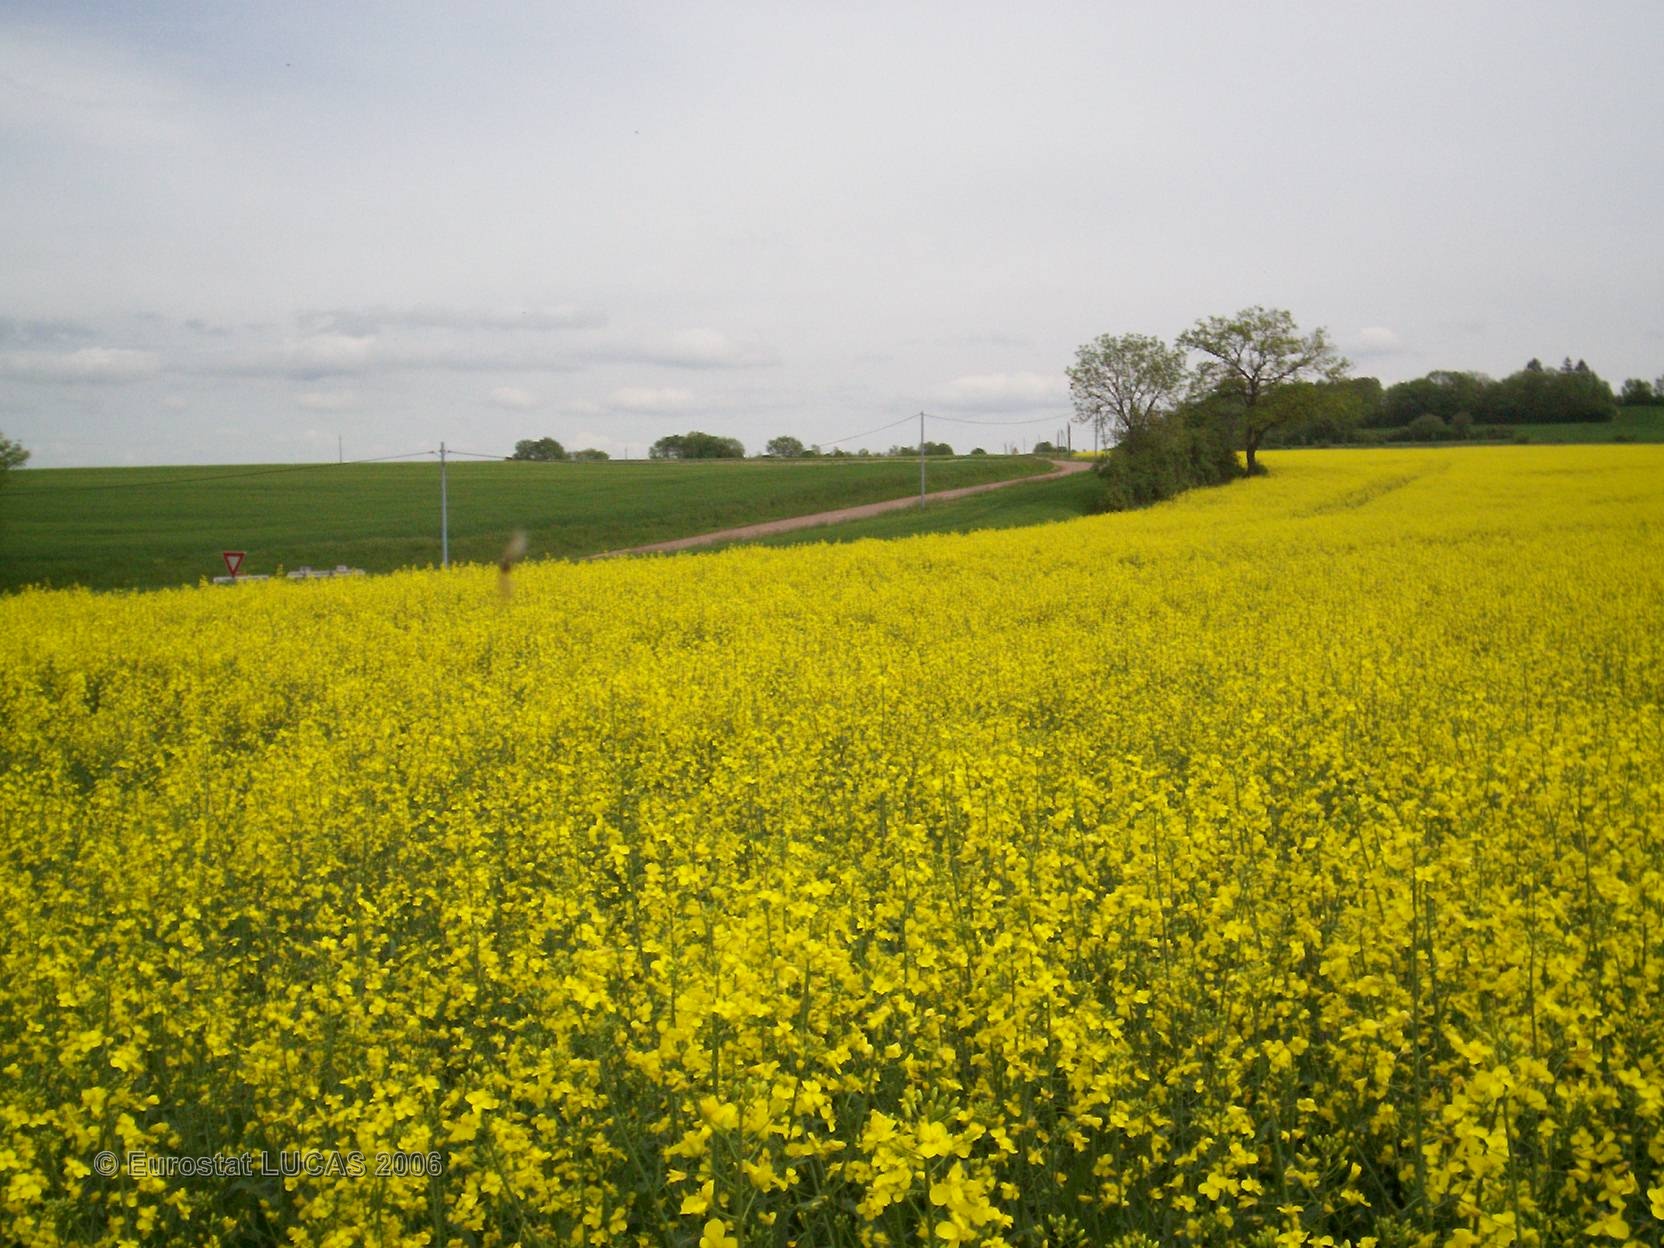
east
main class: Cropland
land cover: Rape and turnip rape
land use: Agriculture (excluding fallow land and kitchen gardens)
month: May
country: FR
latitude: 47.2971
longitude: 4.5909
